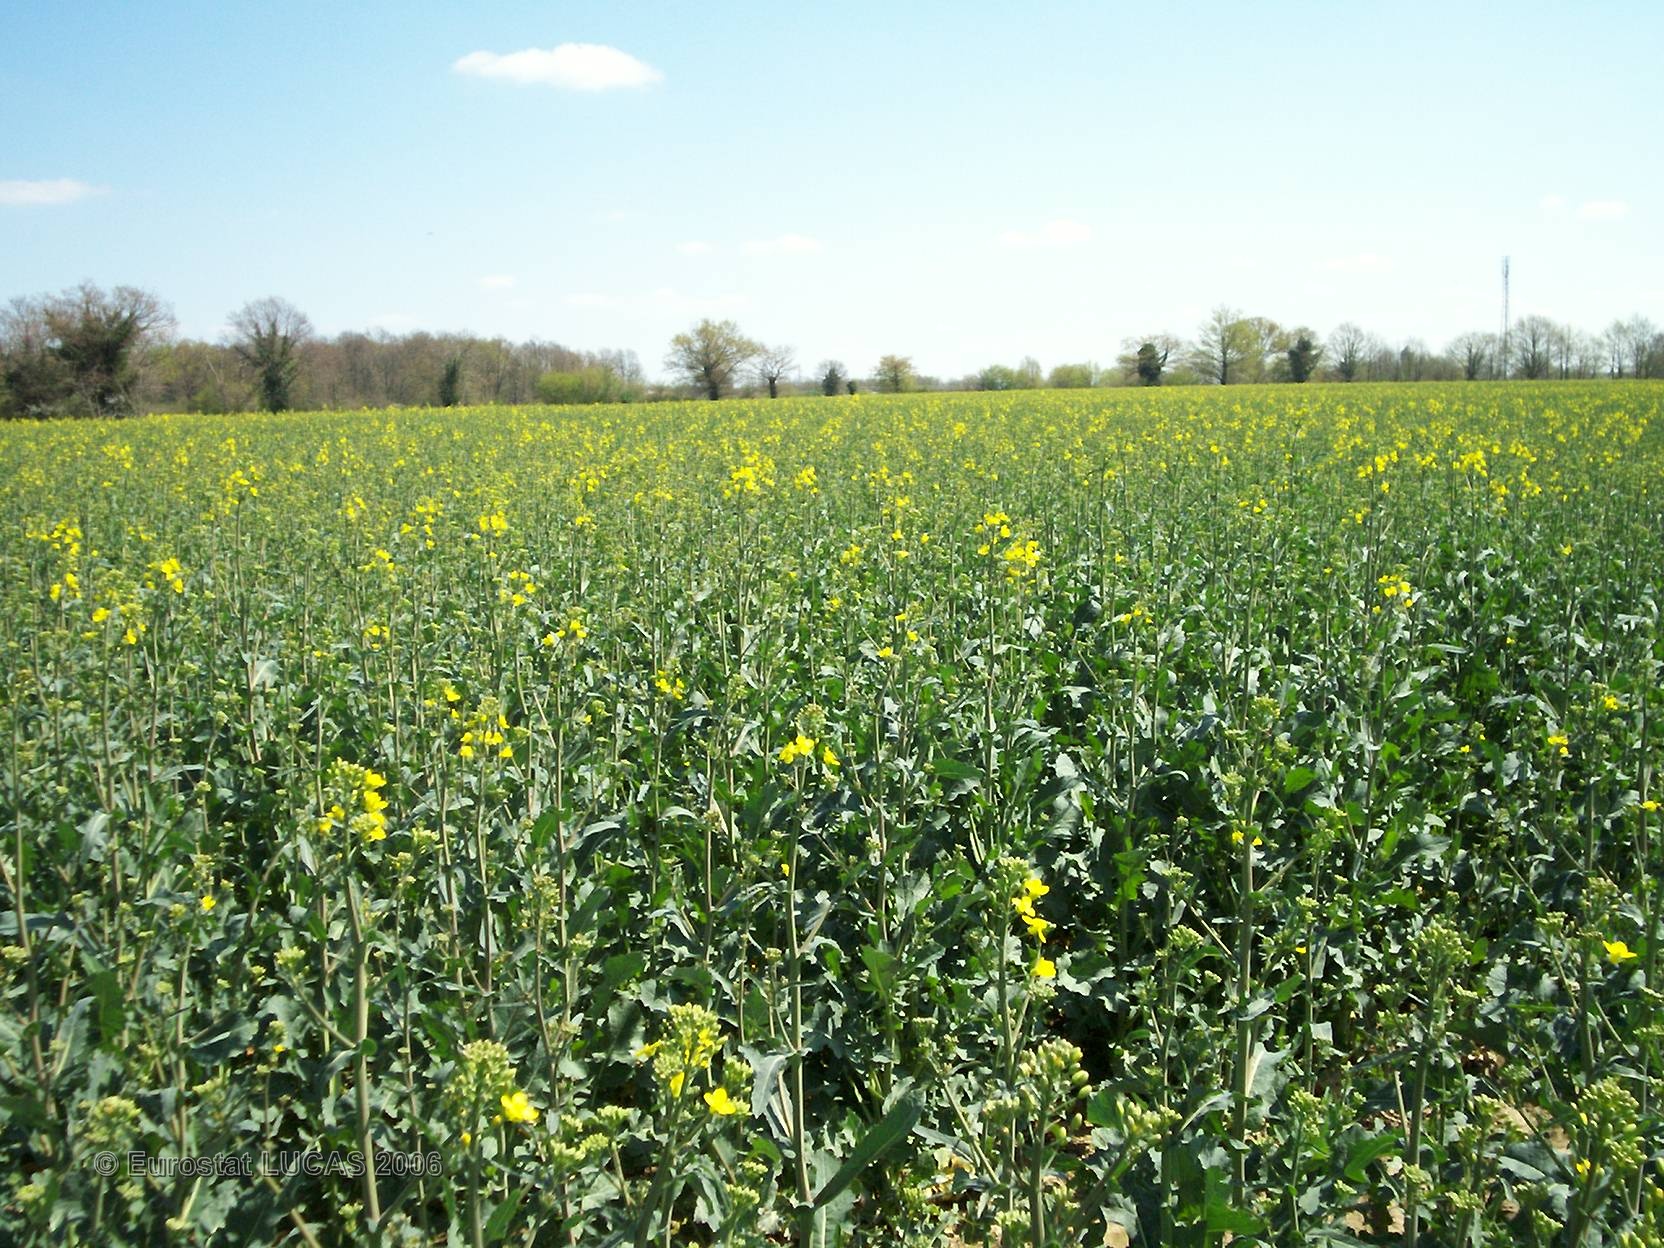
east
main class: Cropland
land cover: Rape and turnip rape
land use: Agriculture (excluding fallow land and kitchen gardens)
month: April
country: FR
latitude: 46.7066
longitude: 1.5791
